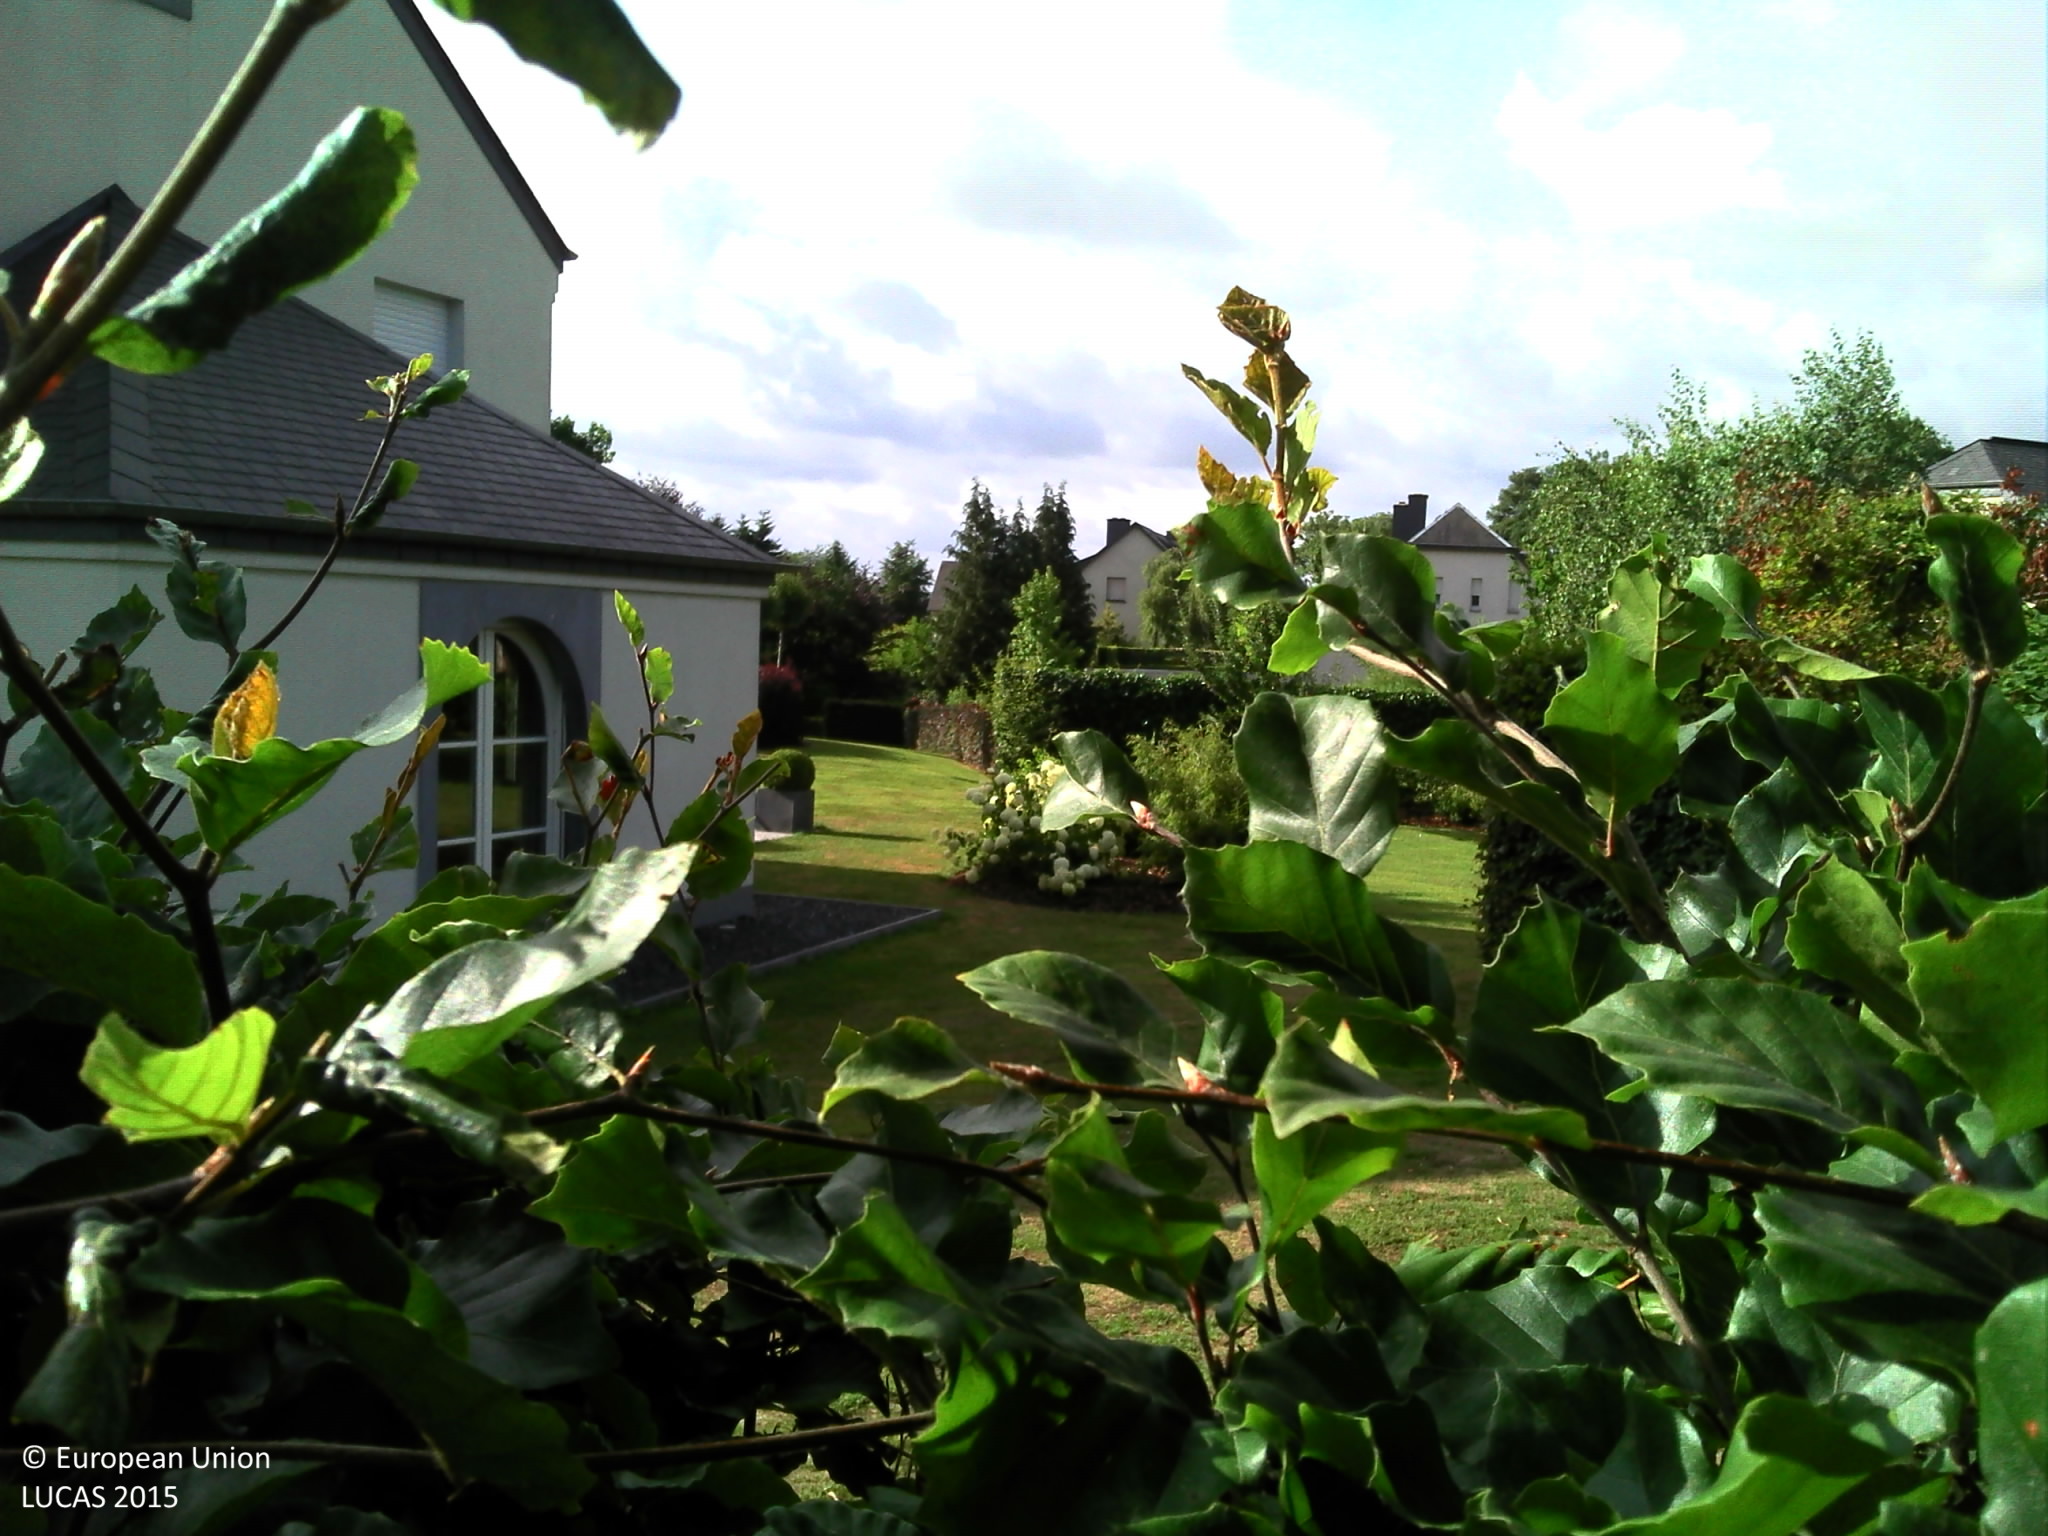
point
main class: Grassland
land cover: Grassland without tree/shrub cover
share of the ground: > 75 %
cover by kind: herbaceous plants 100 %
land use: Residential
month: July
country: BE
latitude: 49.6758
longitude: 5.8278
